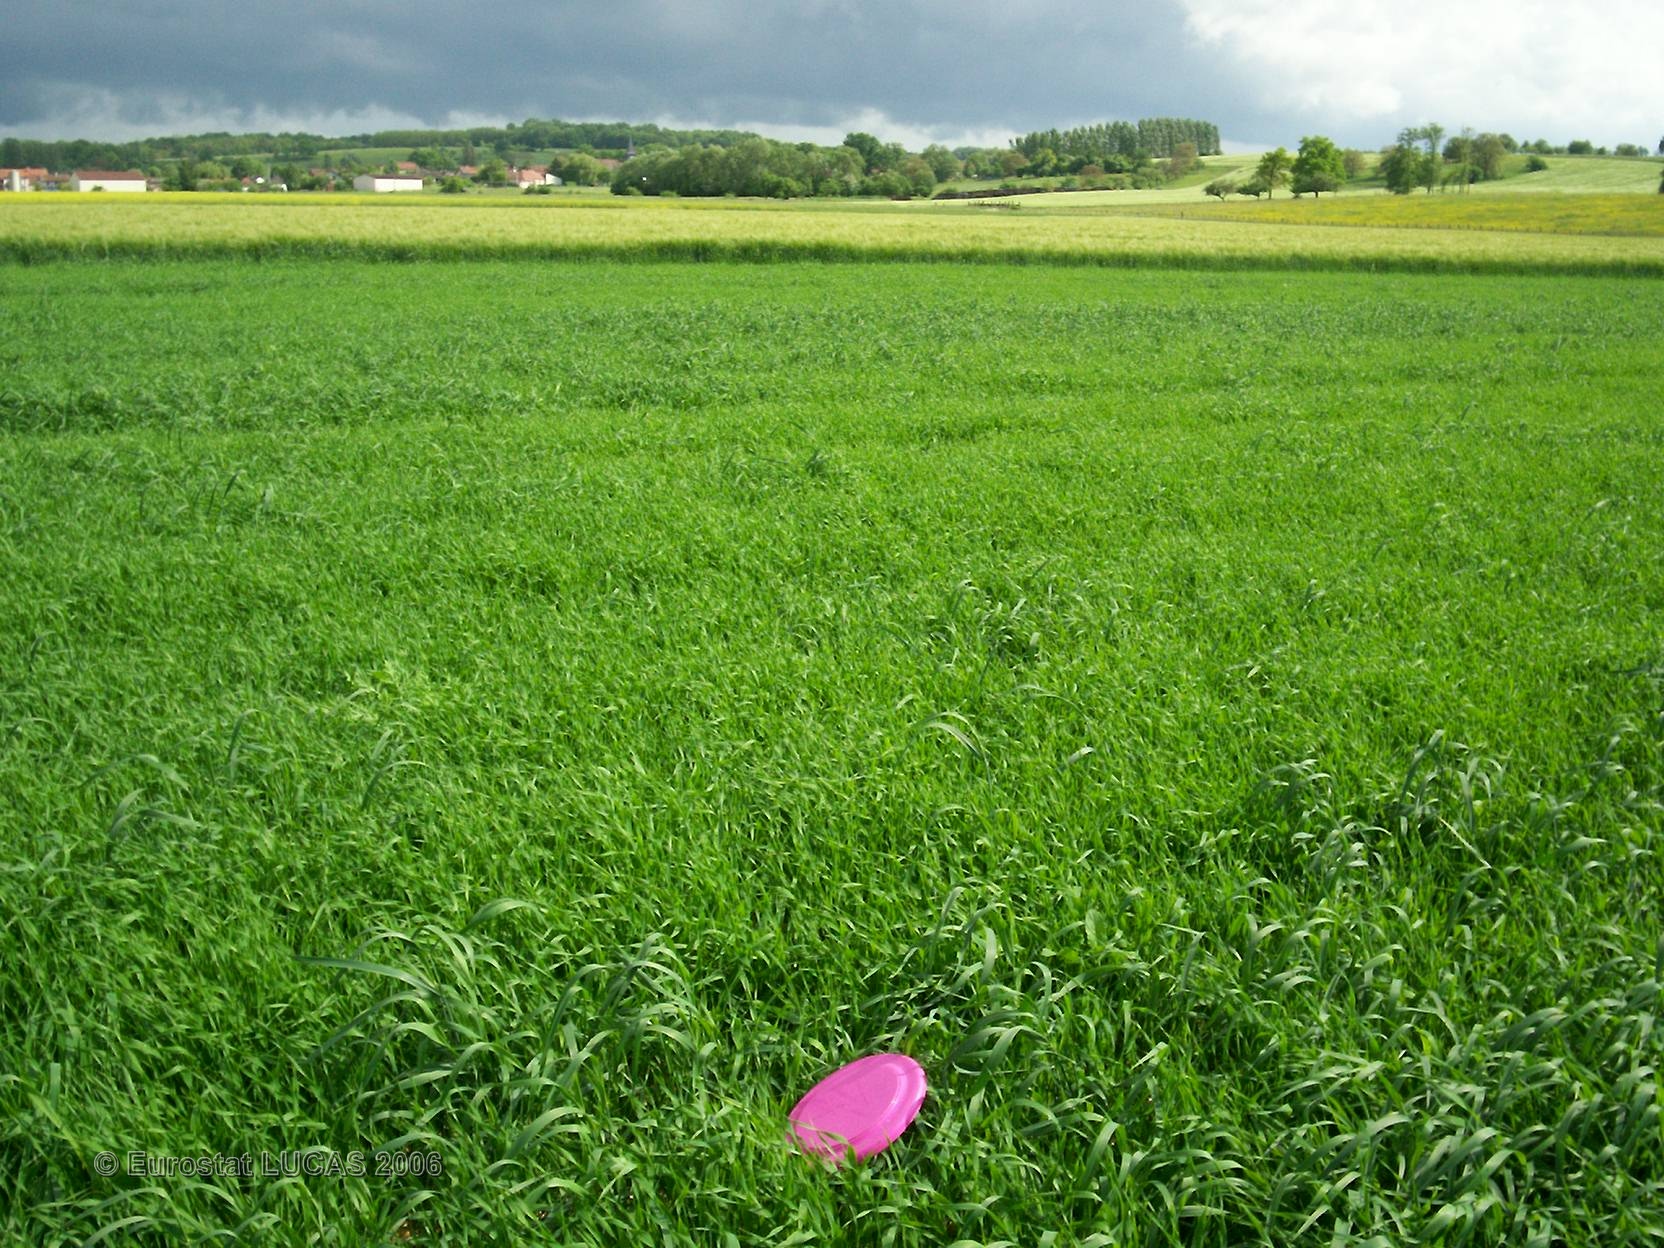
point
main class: Cropland
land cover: Barley
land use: Agriculture (excluding fallow land and kitchen gardens)
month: May
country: FR
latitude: 48.4109
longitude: 4.4988
